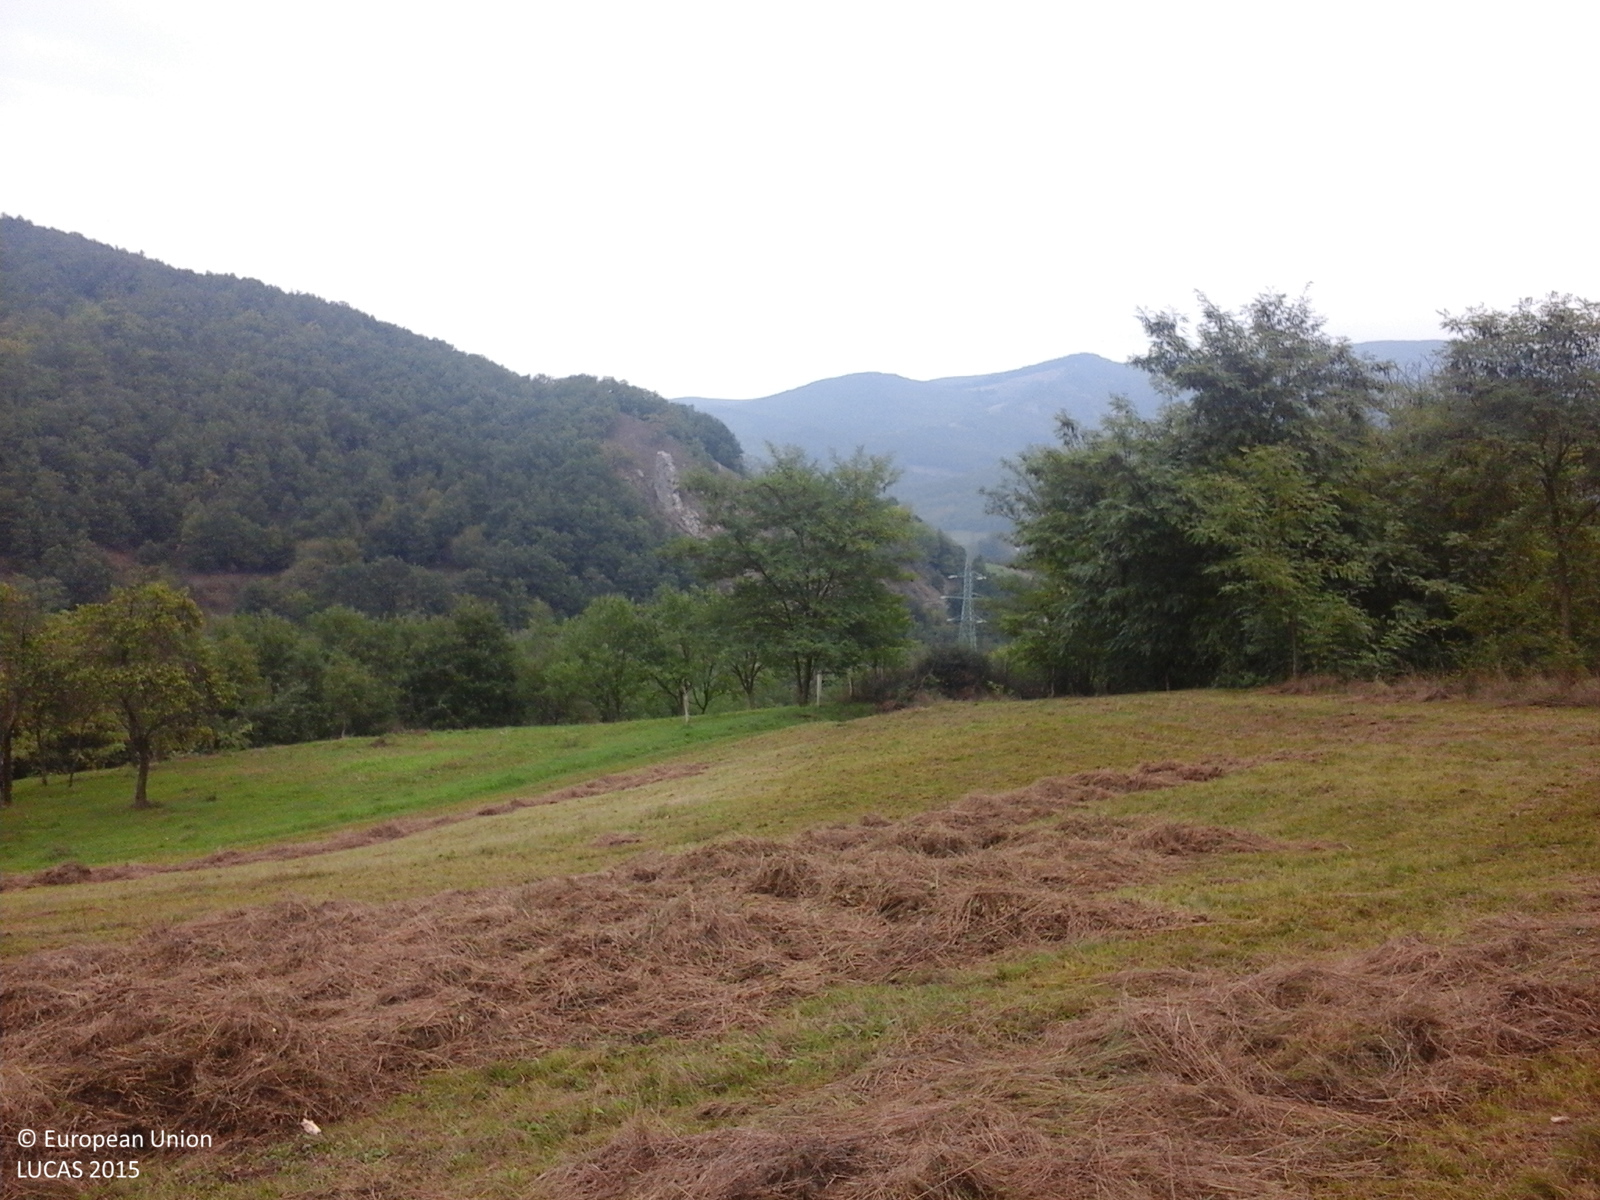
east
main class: Grassland
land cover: Grassland without tree/shrub cover
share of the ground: > 75 %
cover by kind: herbaceous plants 100 %
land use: Agriculture (excluding fallow land and kitchen gardens)
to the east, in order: Grassland without tree/shrub cover; Tracks; Abandoned hedges; Fences; Abandoned hedges; Other fruit trees and berries; Broadleaved woodland; Railways; Lines of trees; Shruby margins; Tracks; Spontaneously vegetated surfaces; Electric lines; Spontaneously vegetated surfaces; Maize; Lucerne; Broadleaved woodland
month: October
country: RO
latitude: 46.0990
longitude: 23.4526
